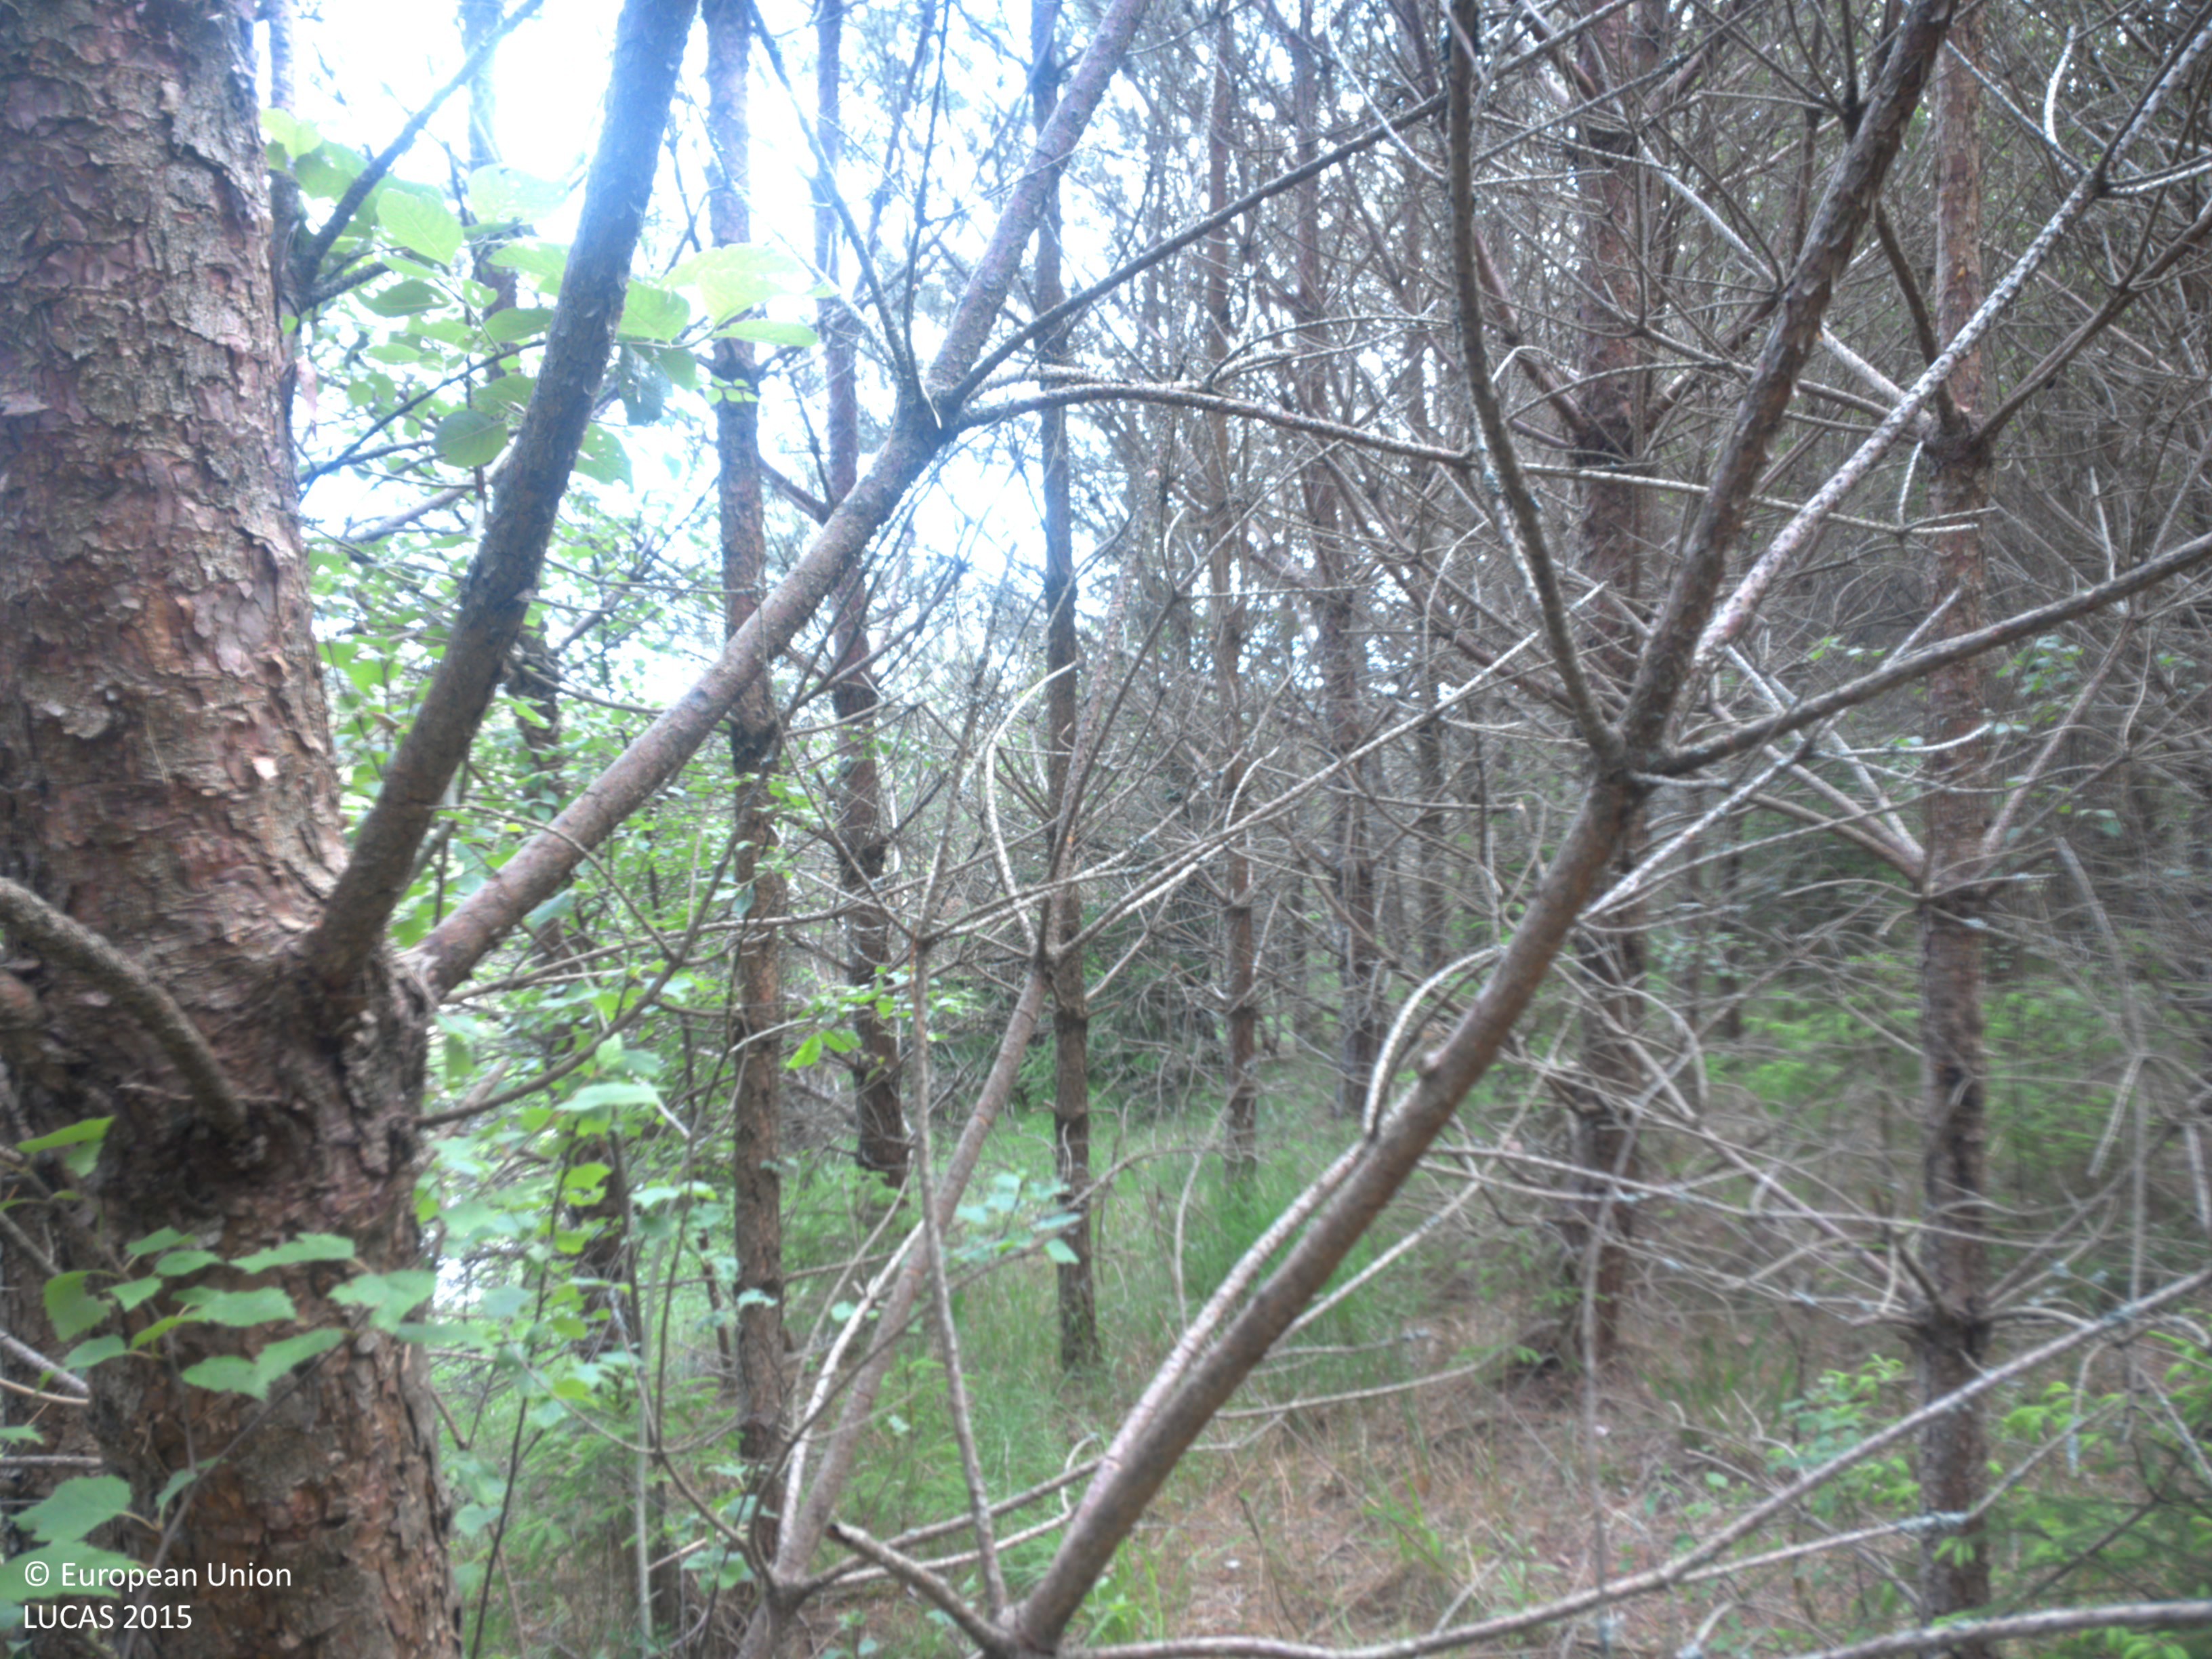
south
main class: Woodland
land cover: Pine dominated coniferous woodland
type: boreal forest
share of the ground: > 75 %
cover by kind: coniferous forest trees 80 %, herbaceous plants 10 %, lichens and mosses 10 %
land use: Forestry
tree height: < 5 m
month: June
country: SE
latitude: 58.8216
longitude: 11.6069
